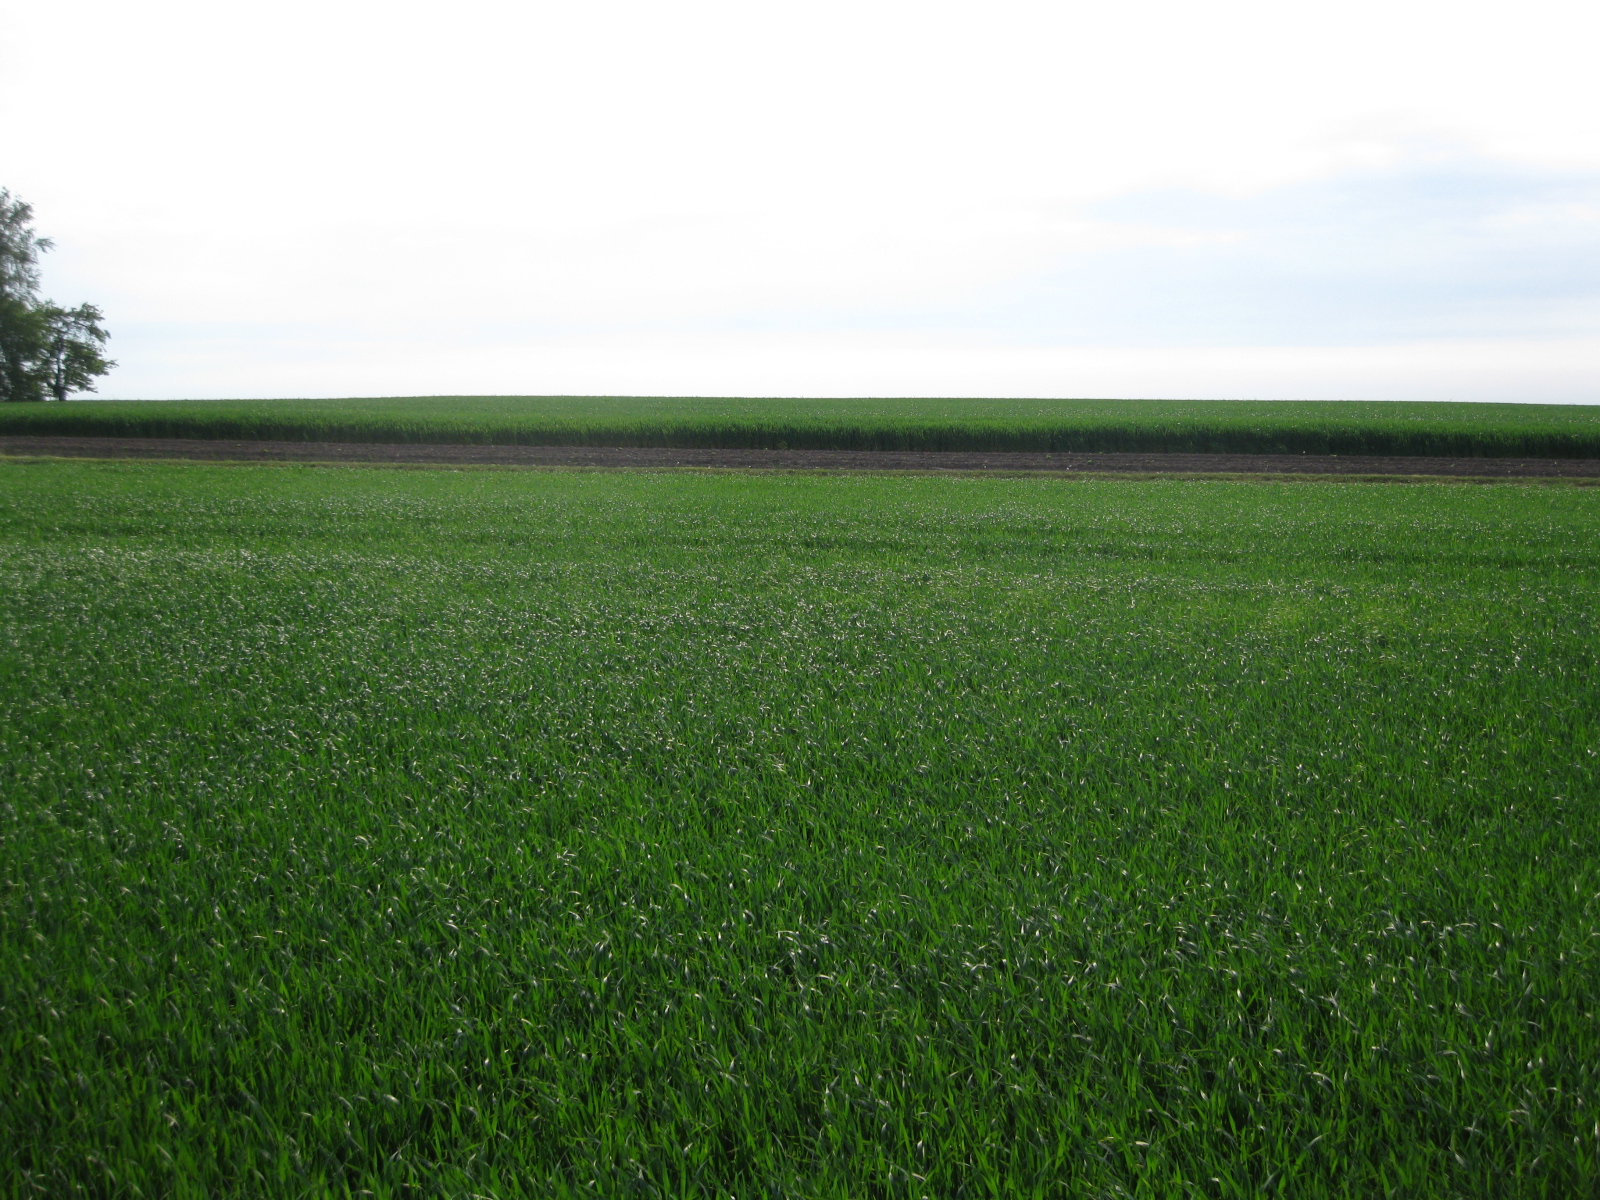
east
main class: Cropland
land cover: Common wheat
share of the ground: > 75 %
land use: Agriculture (excluding fallow land and kitchen gardens)
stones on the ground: < 10 %
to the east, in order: Common wheat; Grass margins; Tracks; Grass margins; Other root crops; Potatoes; Common wheat
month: June
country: LT
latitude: 55.7966
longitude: 23.6878
